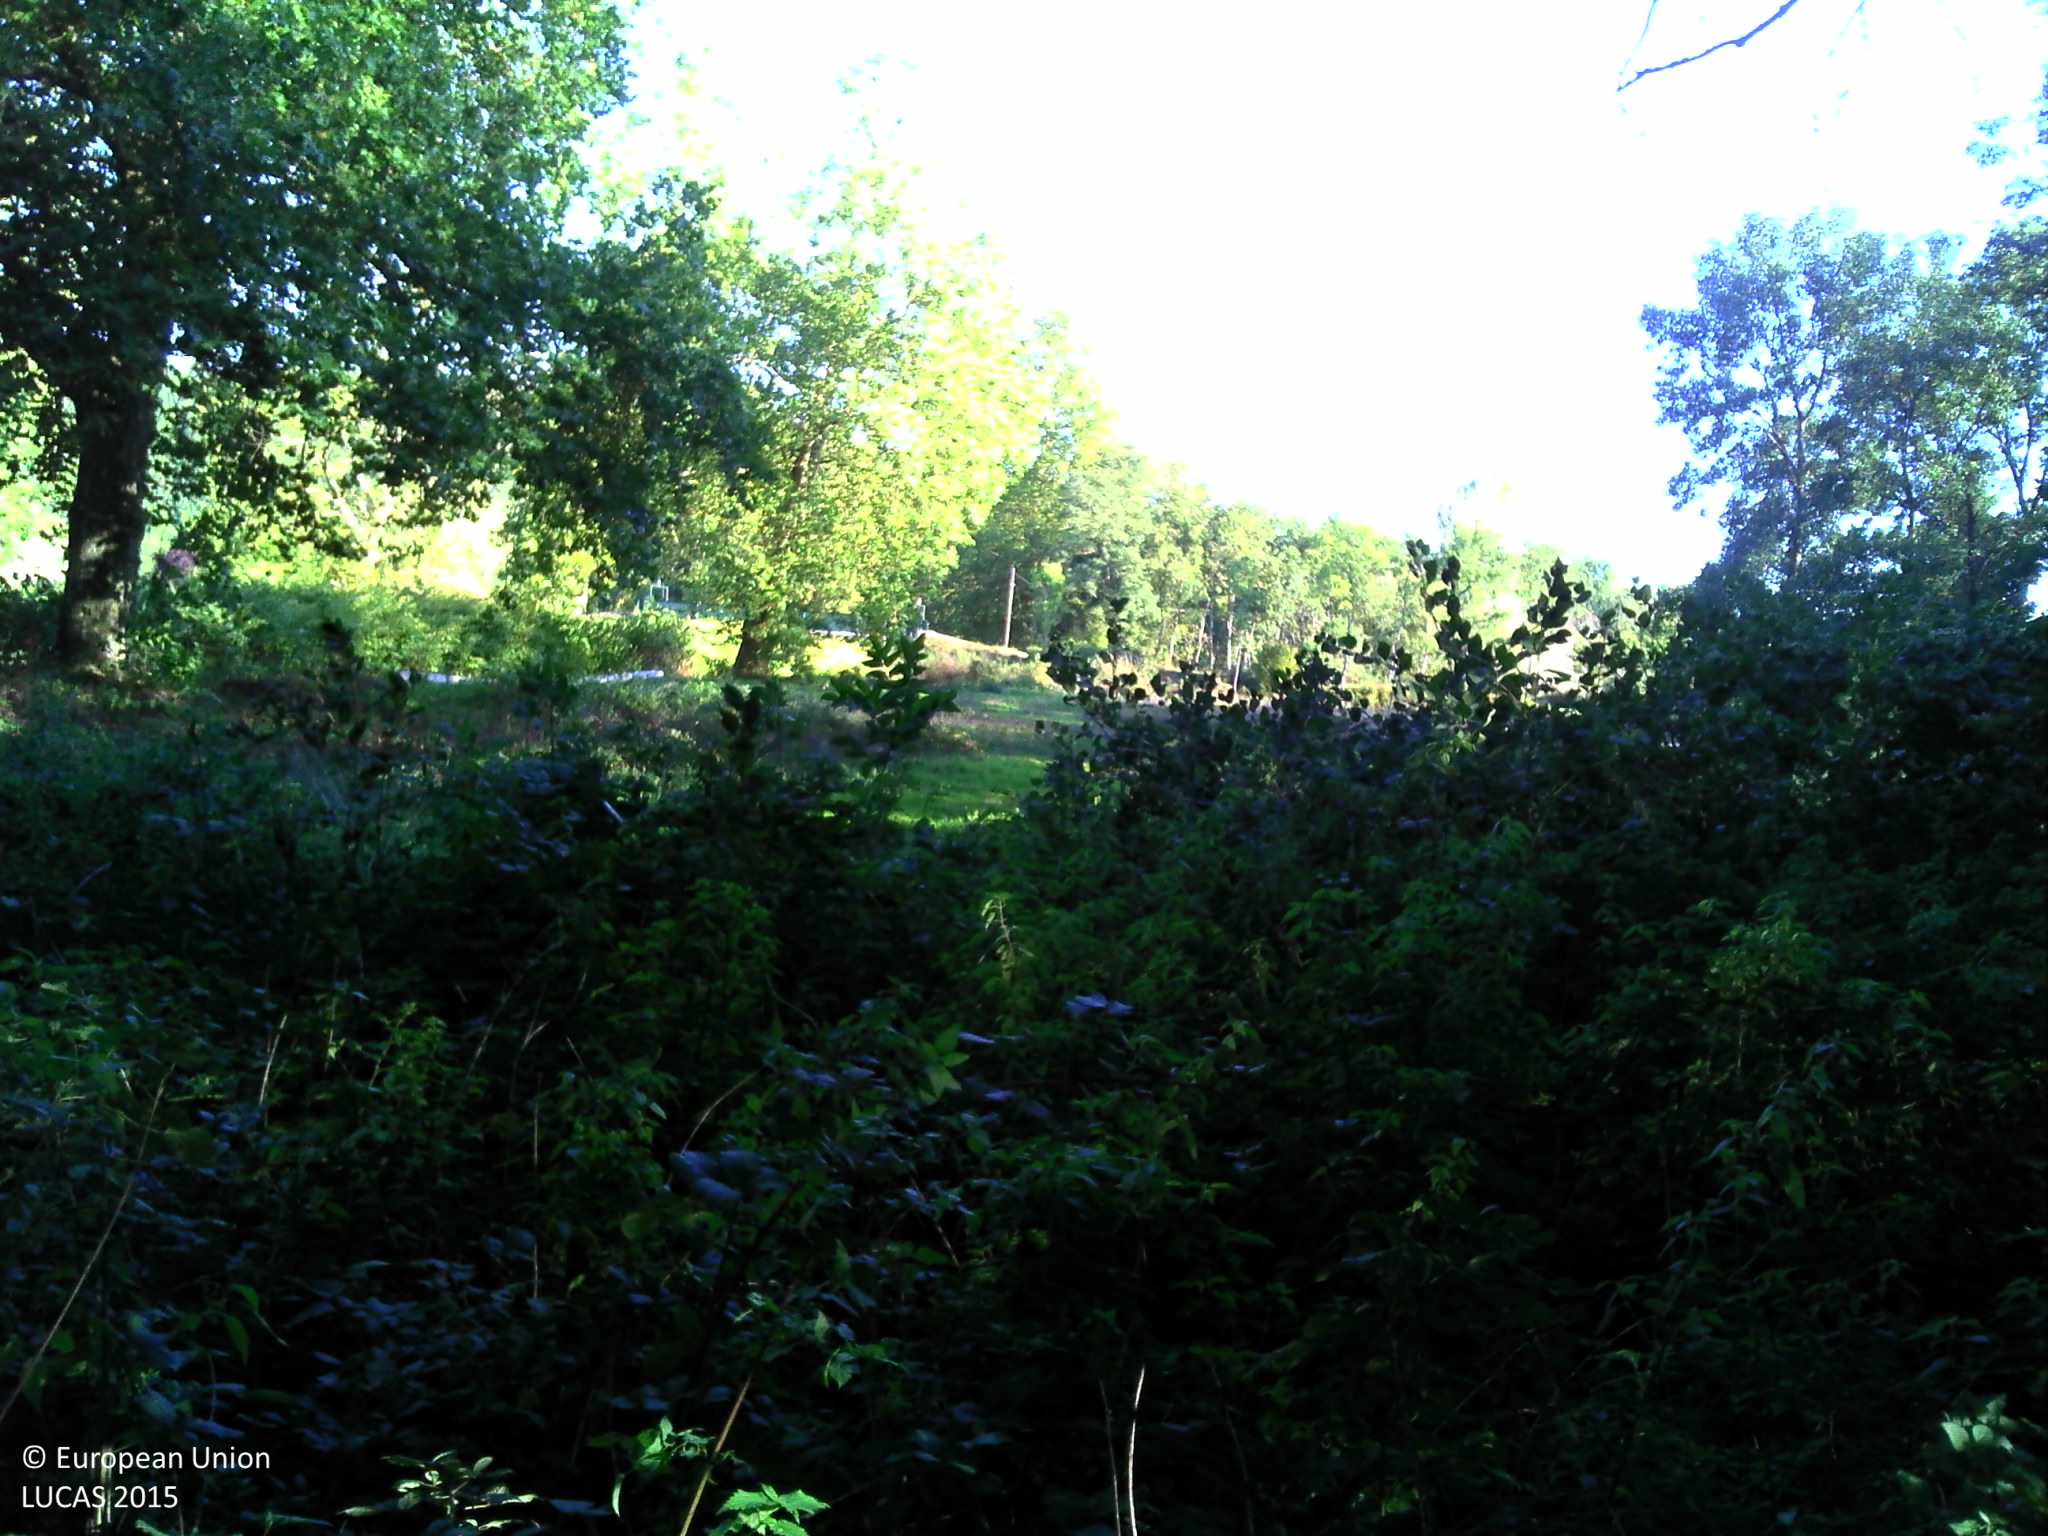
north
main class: Woodland
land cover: Broadleaved woodland
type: floodplain forest
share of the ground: > 75 %
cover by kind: broadleaved forest trees 85 %, herbaceous plants 10 %, consolidated bare surface 5 %
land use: Semi-natural and natural areas not in use
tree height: > 5 m
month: September
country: FR
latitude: 48.4123
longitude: 6.2580
